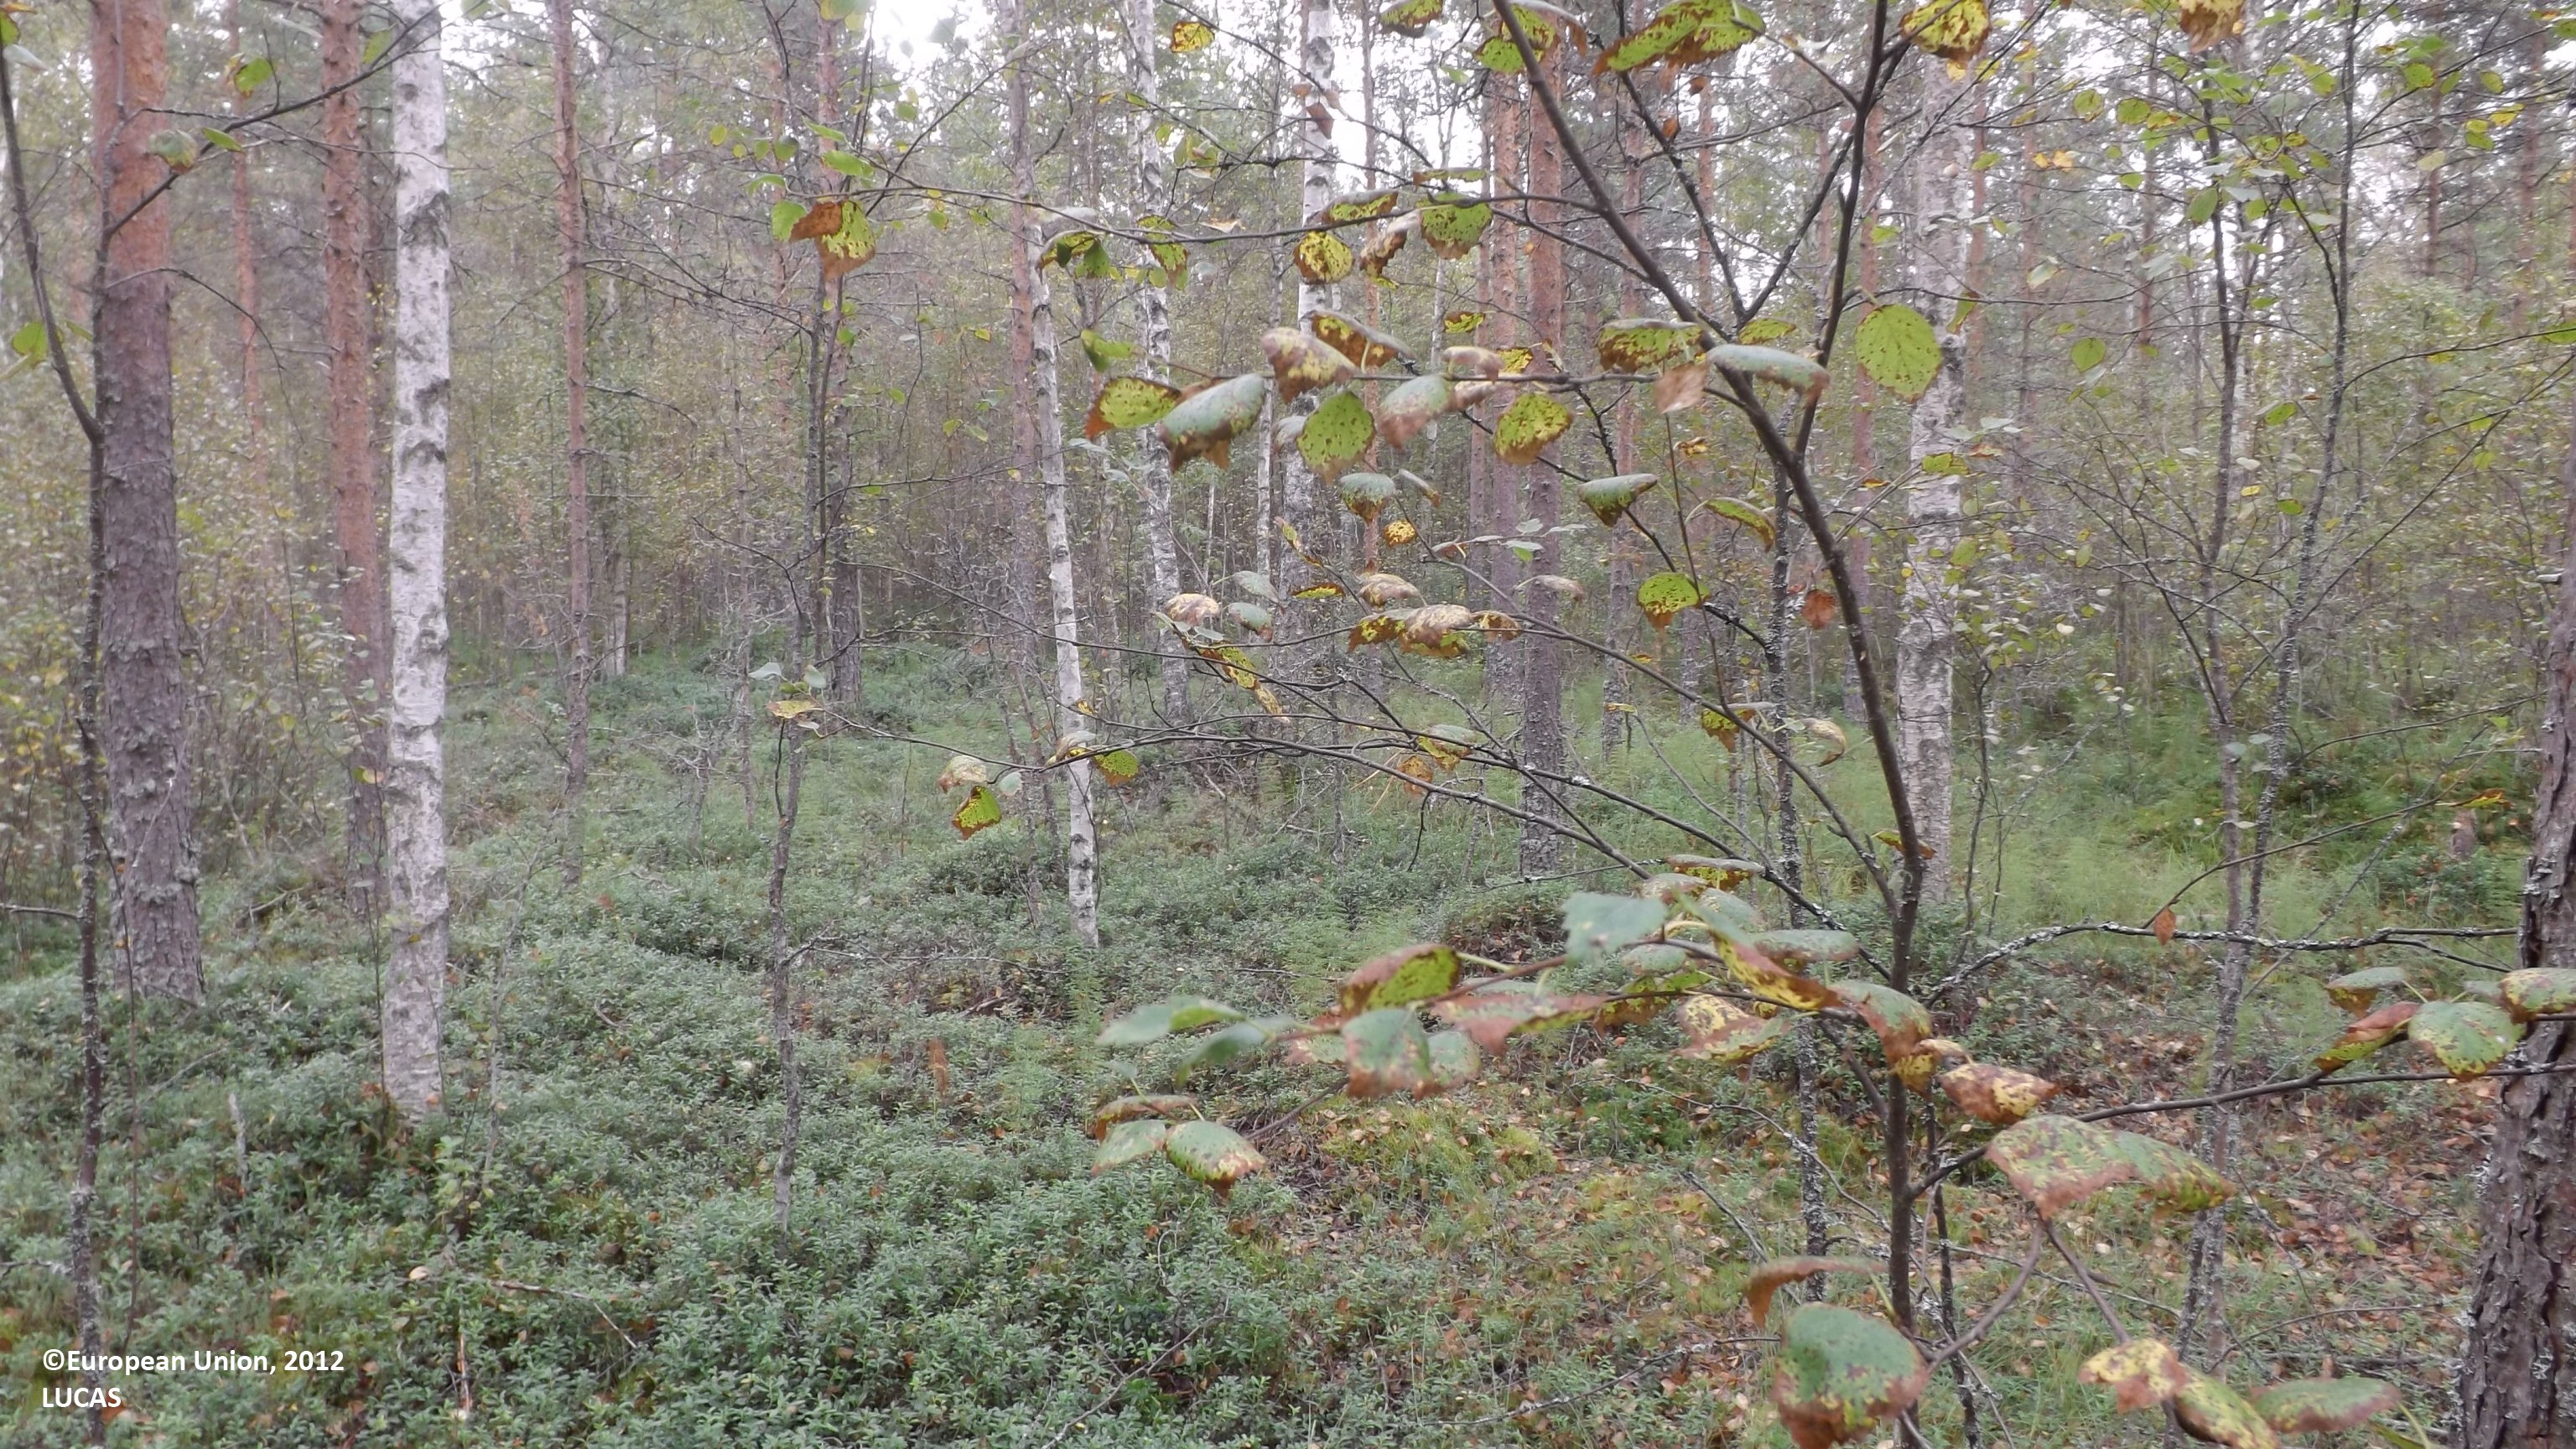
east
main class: Woodland
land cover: Pine dominated mixed woodland
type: boreal forest
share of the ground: > 75 %
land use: Forestry
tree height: > 5 m
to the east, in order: Pine dominated mixed woodland; Ditches and canals; Pine dominated mixed woodland; Ditches and canals; Pine dominated mixed woodland; Ditches and canals; Pine dominated mixed woodland
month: August
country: FI
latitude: 63.8758
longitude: 23.8861
